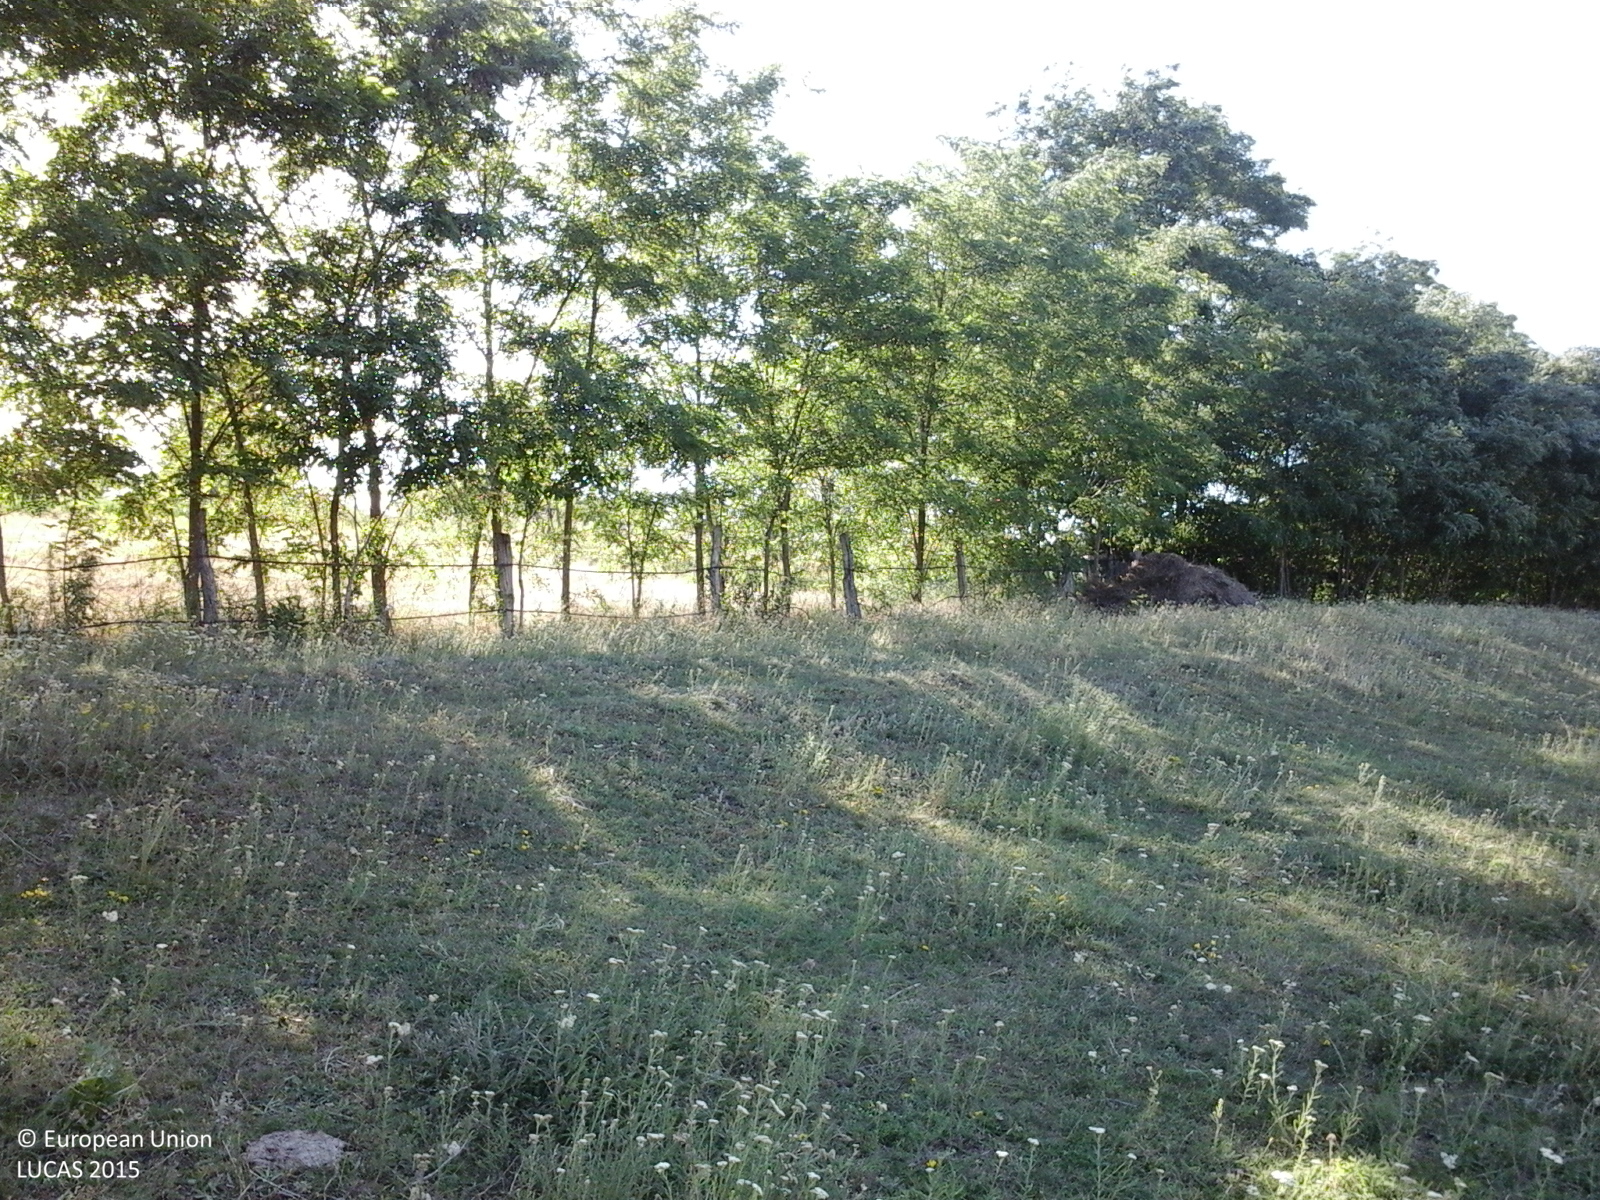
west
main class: Grassland
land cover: Grassland without tree/shrub cover
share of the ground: > 75 %
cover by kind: herbaceous plants 100 %
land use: Agriculture (excluding fallow land and kitchen gardens)
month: June
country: RO
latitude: 48.0532
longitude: 26.9702
